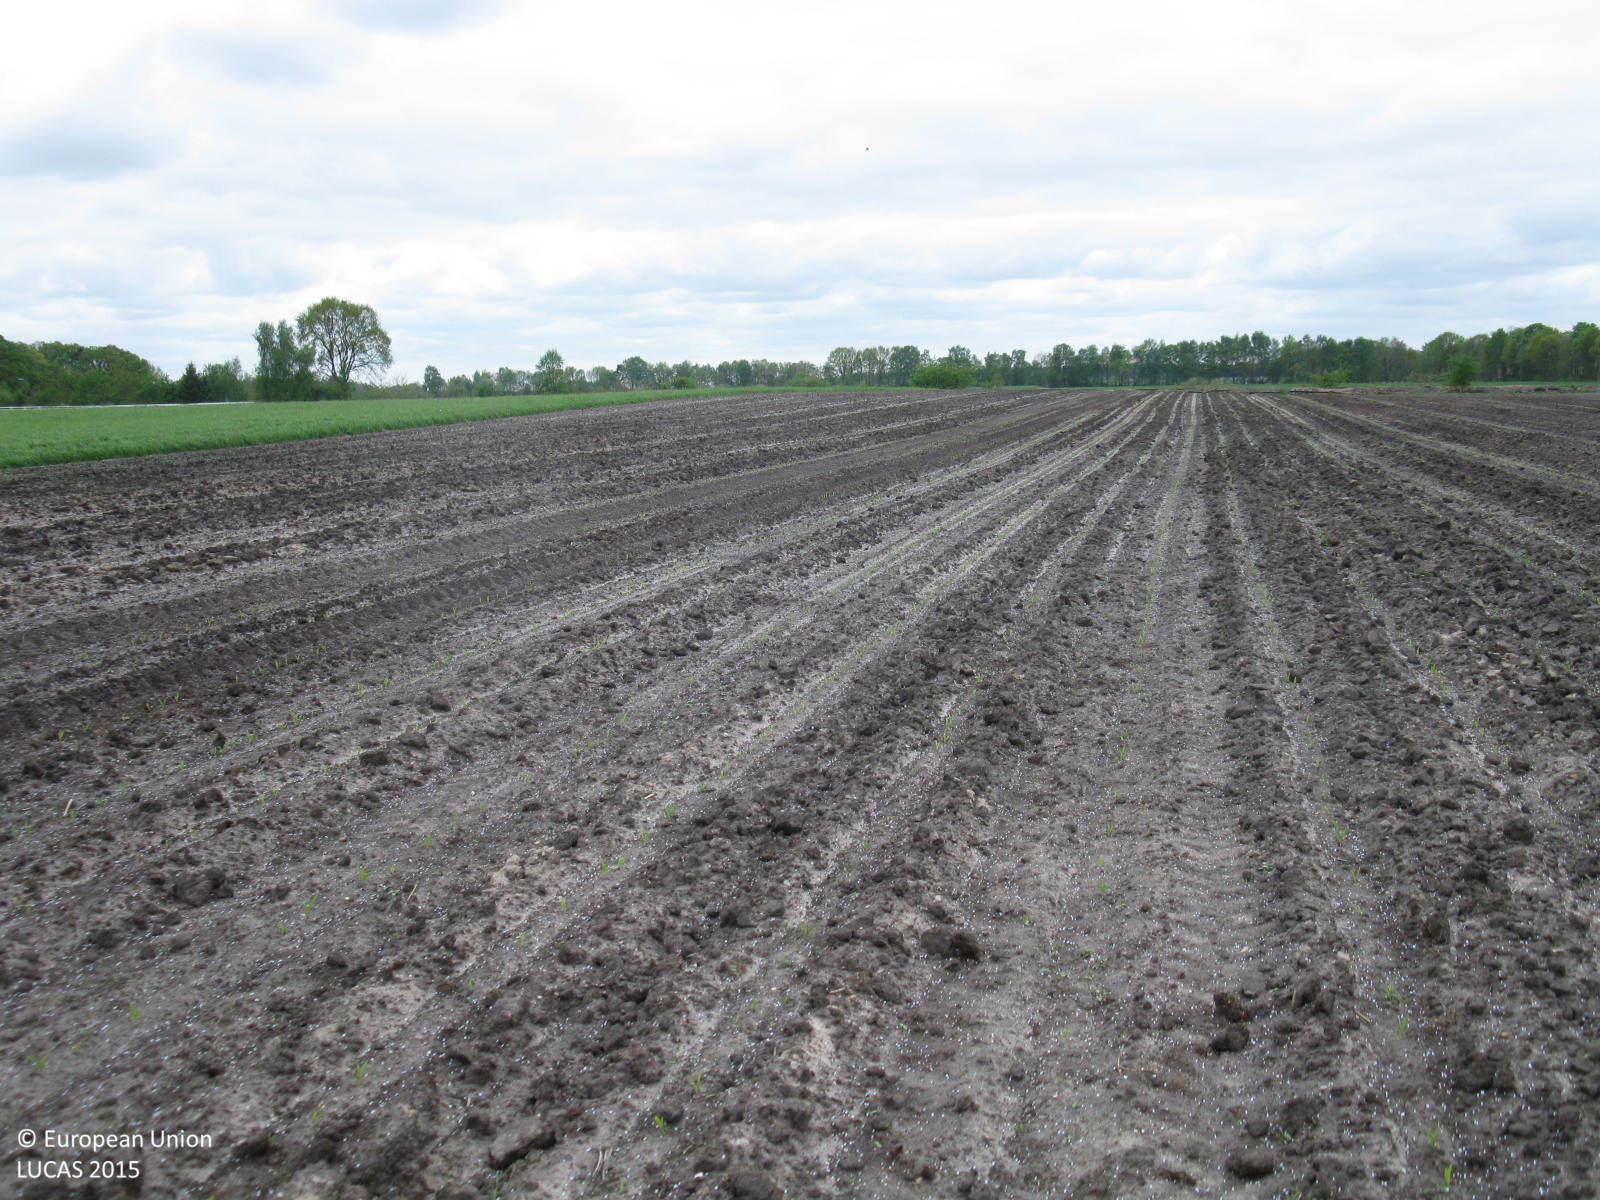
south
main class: Cropland
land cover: Maize
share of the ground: < 10 %
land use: Agriculture (excluding fallow land and kitchen gardens)
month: May
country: DE
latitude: 52.8520
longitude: 7.3720
